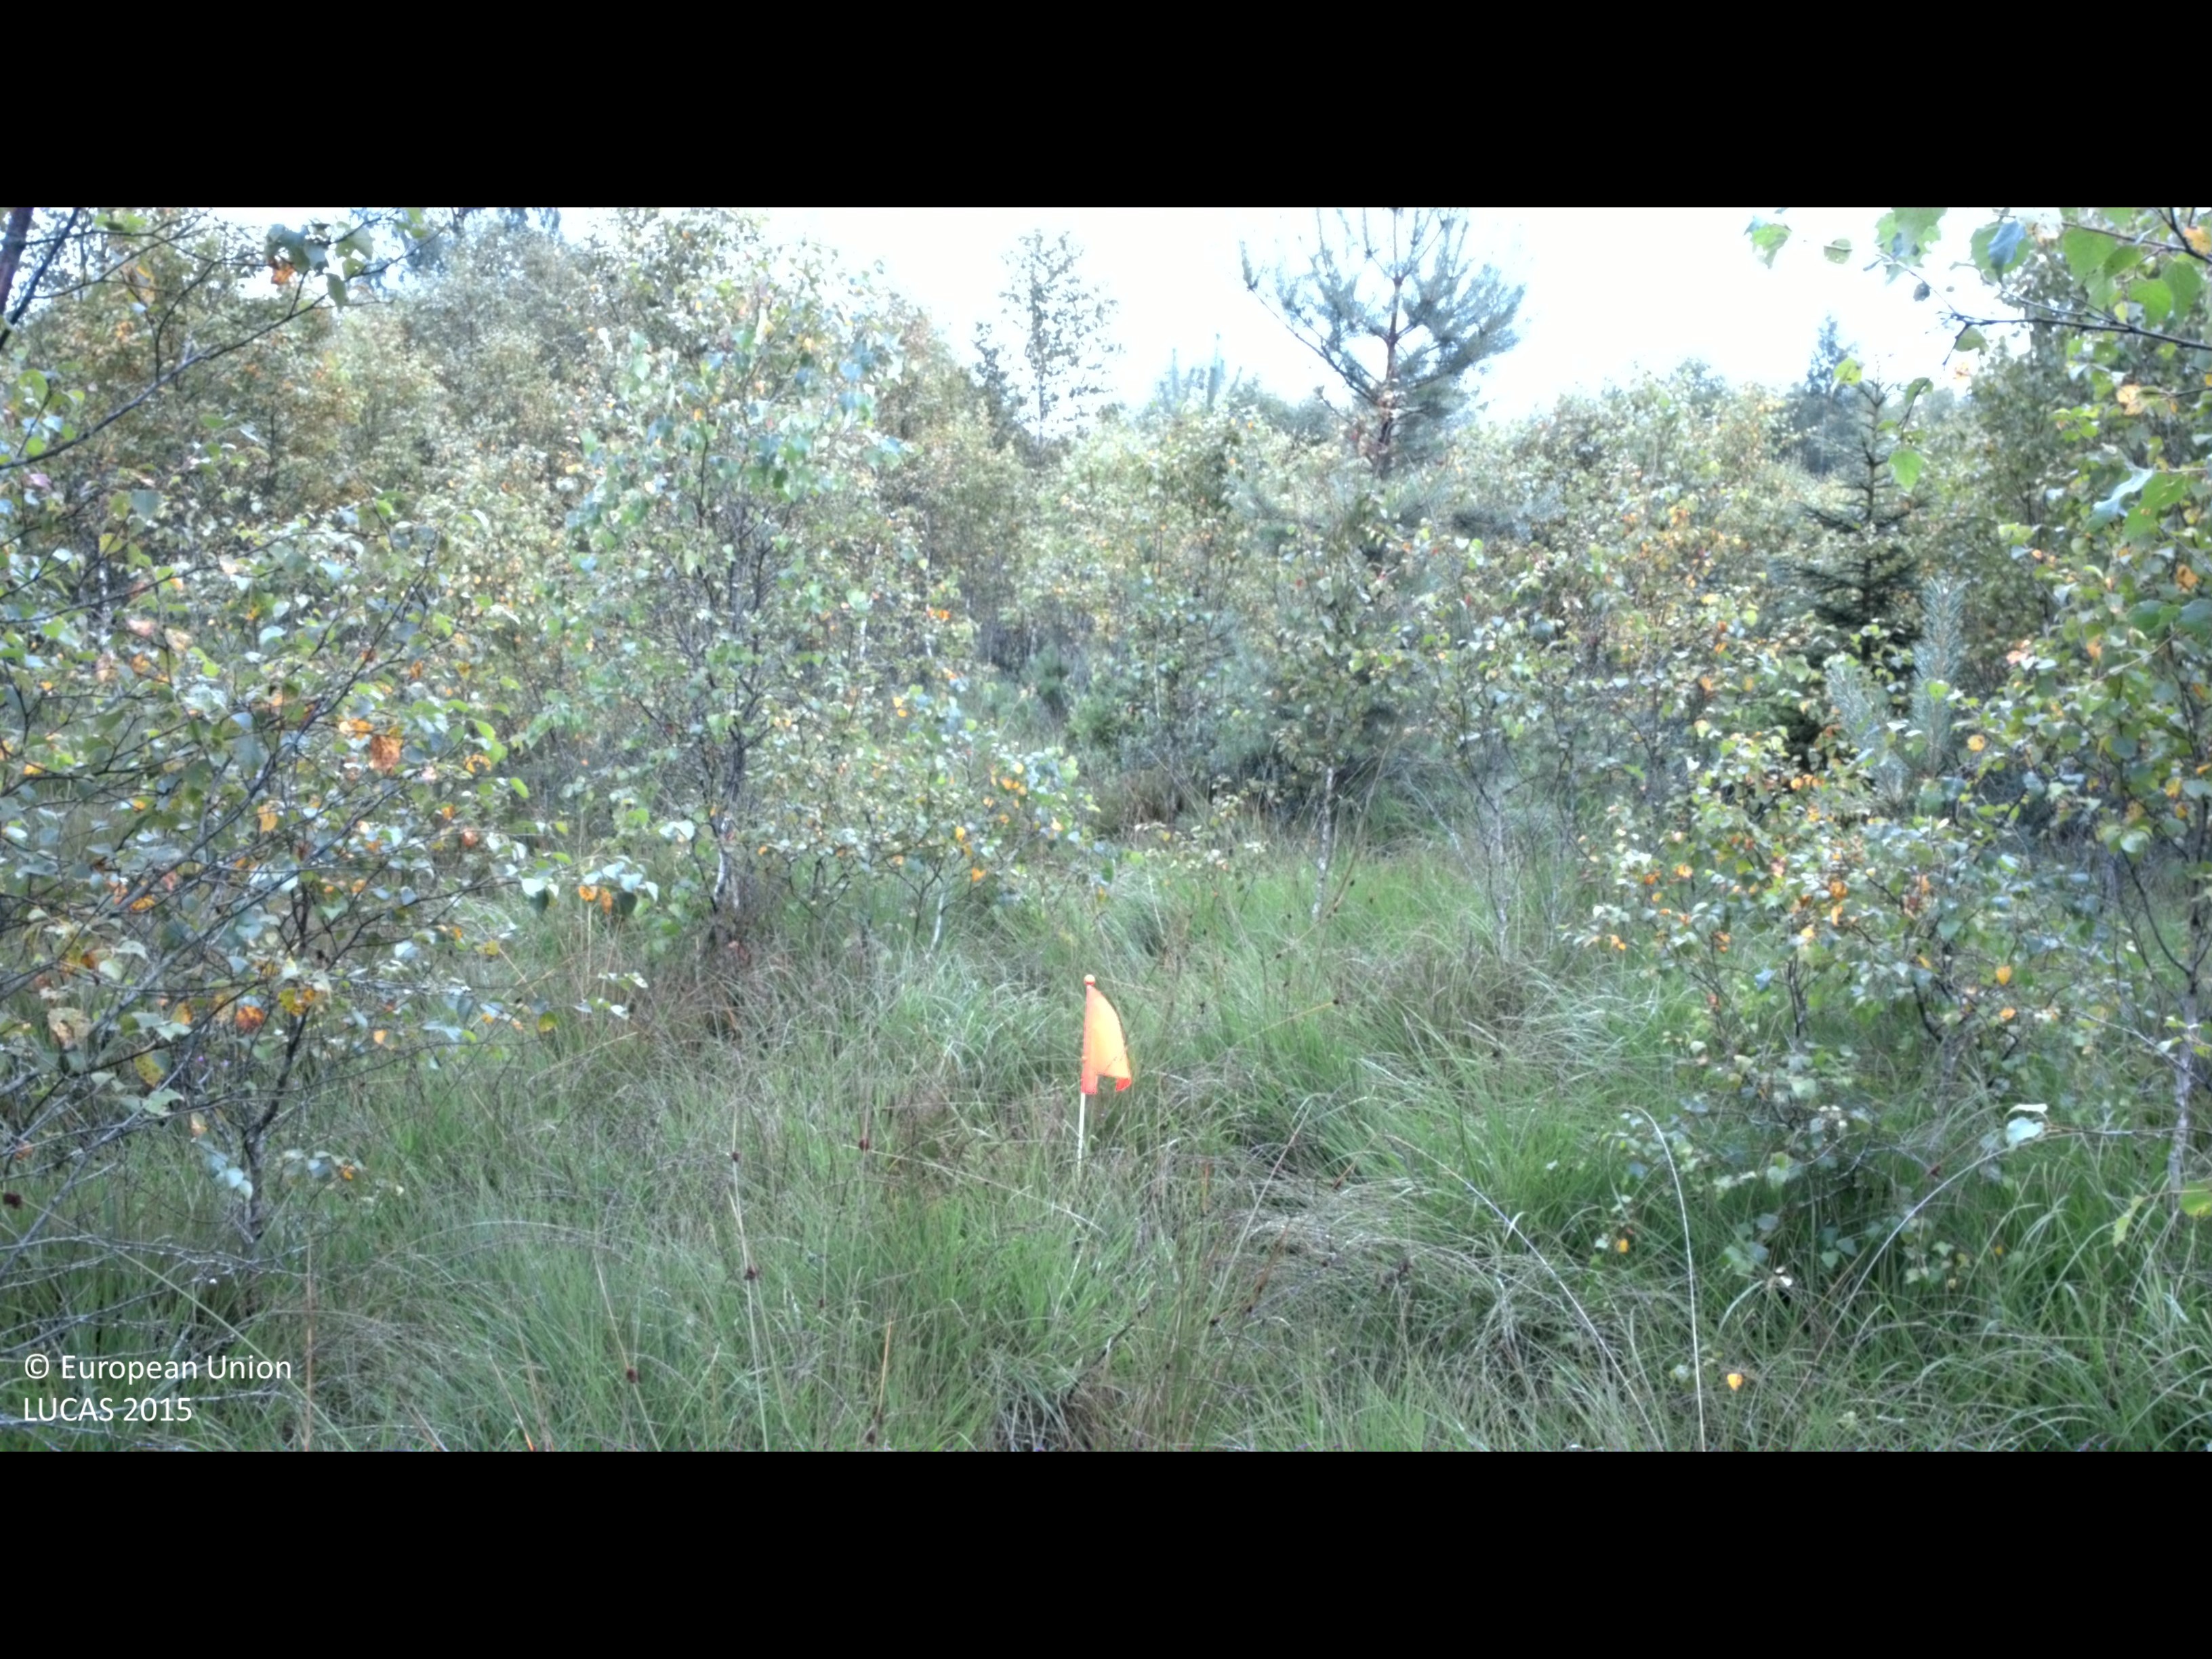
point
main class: Woodland
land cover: Spruce dominated mixed woodland
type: boreal forest
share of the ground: 50 - 75 %
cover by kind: broadleaved forest trees 45 %, herbaceous plants 35 %, coniferous forest trees 15 %, shrubs 5 %
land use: Forestry
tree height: < 5 m
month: August
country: SE
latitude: 56.7424
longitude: 13.8389
